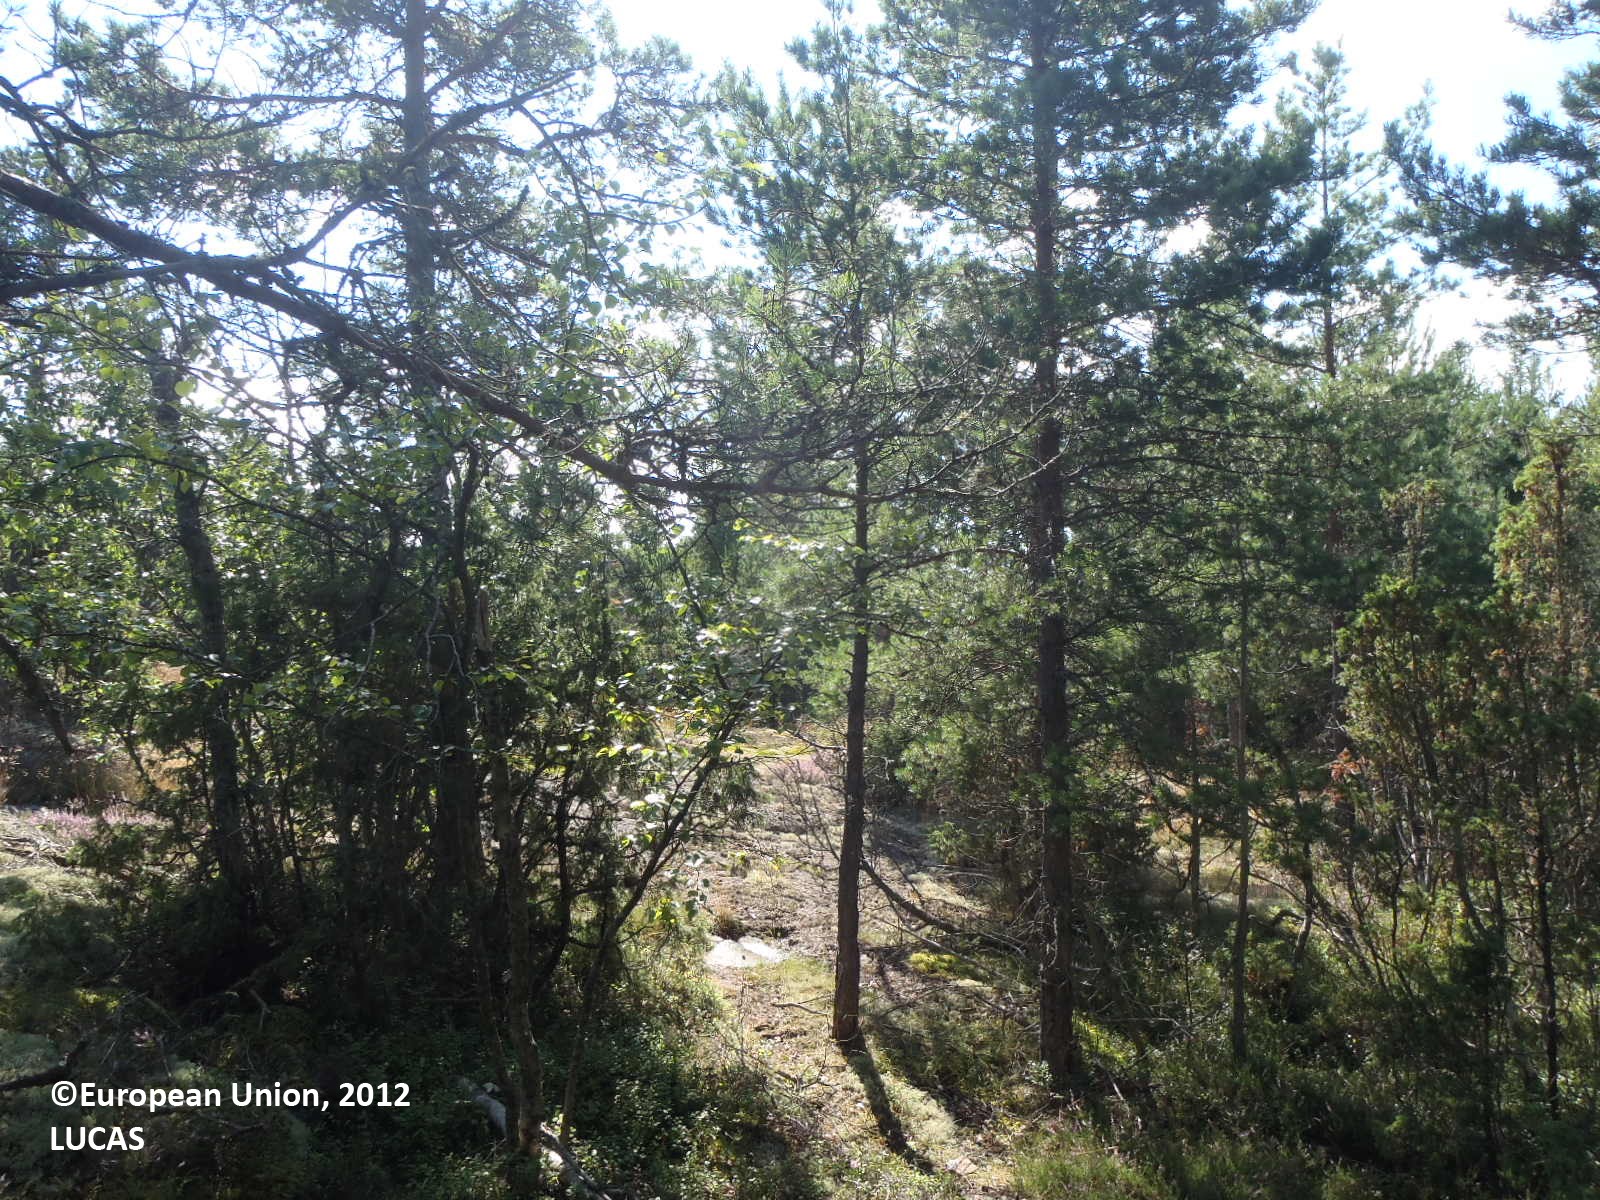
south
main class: Woodland
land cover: Pine dominated coniferous woodland
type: hemiboreal forest and nemoral coniferous forest and mixed broadleaved-coniferous forest
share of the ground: > 75 %
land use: Forestry
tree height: > 5 m
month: August
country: FI
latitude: 60.1741
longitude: 19.9382
